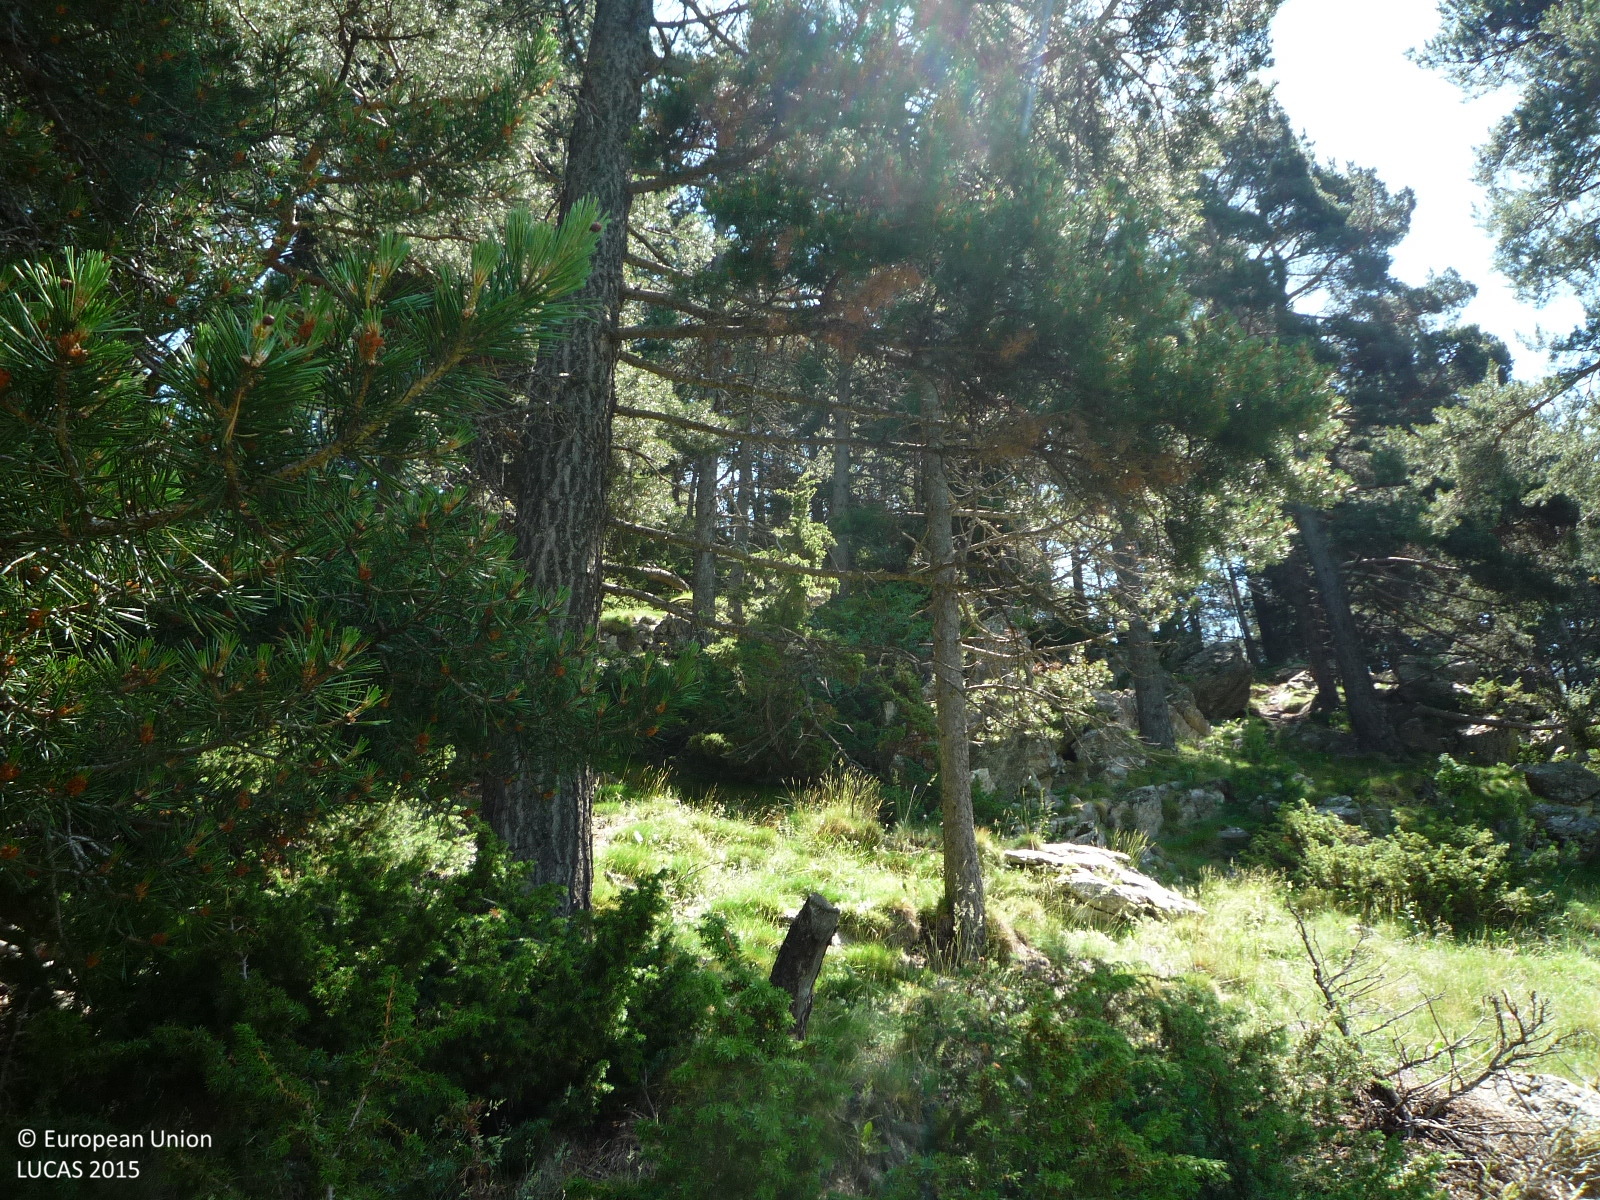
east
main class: Woodland
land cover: Pine dominated coniferous woodland
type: alpine coniferous forest
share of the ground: > 75 %
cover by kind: coniferous forest trees 80 %, shrubs 10 %, herbaceous plants 10 %
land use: Sport
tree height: > 5 m
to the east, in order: Pine dominated coniferous woodland; Grassland without tree/shrub cover; Tracks; Grassland without tree/shrub cover; Electric lines; Grassland without tree/shrub cover; Pine dominated coniferous woodland; Tracks; Pine dominated coniferous woodland; Tracks; Grassland with sparse tree/shrub cover; Pine dominated coniferous woodland
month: June
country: ES
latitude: 42.3325
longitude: 1.9412
